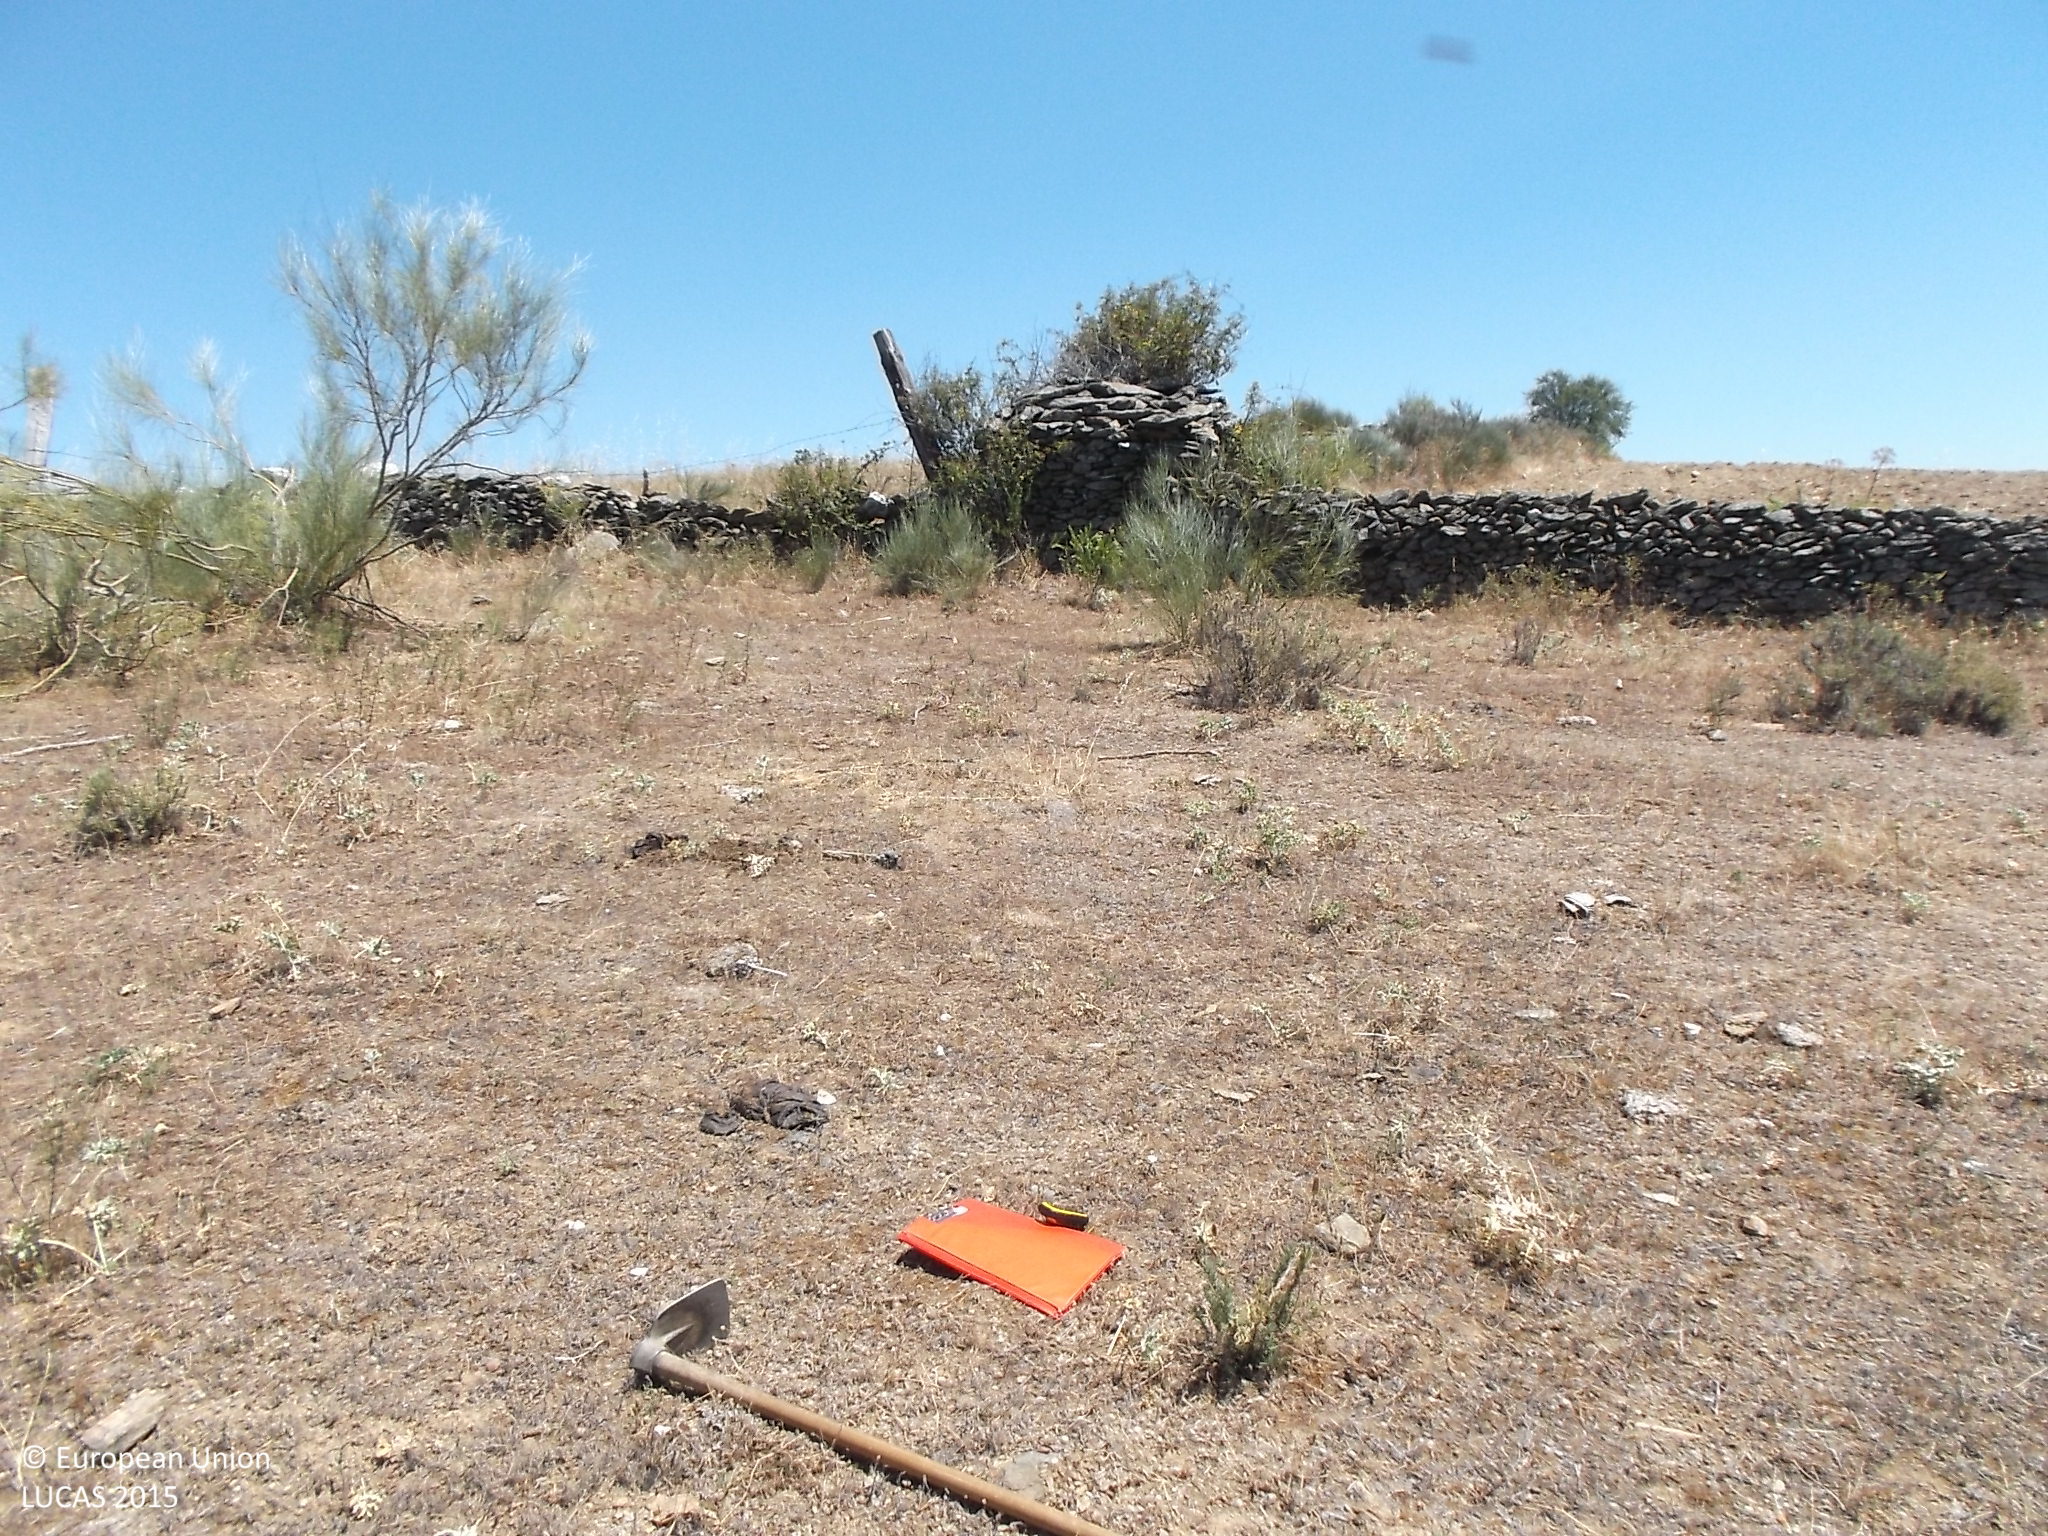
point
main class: Grassland
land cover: Grassland with sparse tree/shrub cover
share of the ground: > 75 %
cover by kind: herbaceous plants 90 %, broadleaved forest trees 5 %, shrubs 5 %
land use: Agriculture (excluding fallow land and kitchen gardens)
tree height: < 5 m
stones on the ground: < 10 %
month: July
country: ES
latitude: 41.0027
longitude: -6.7820
